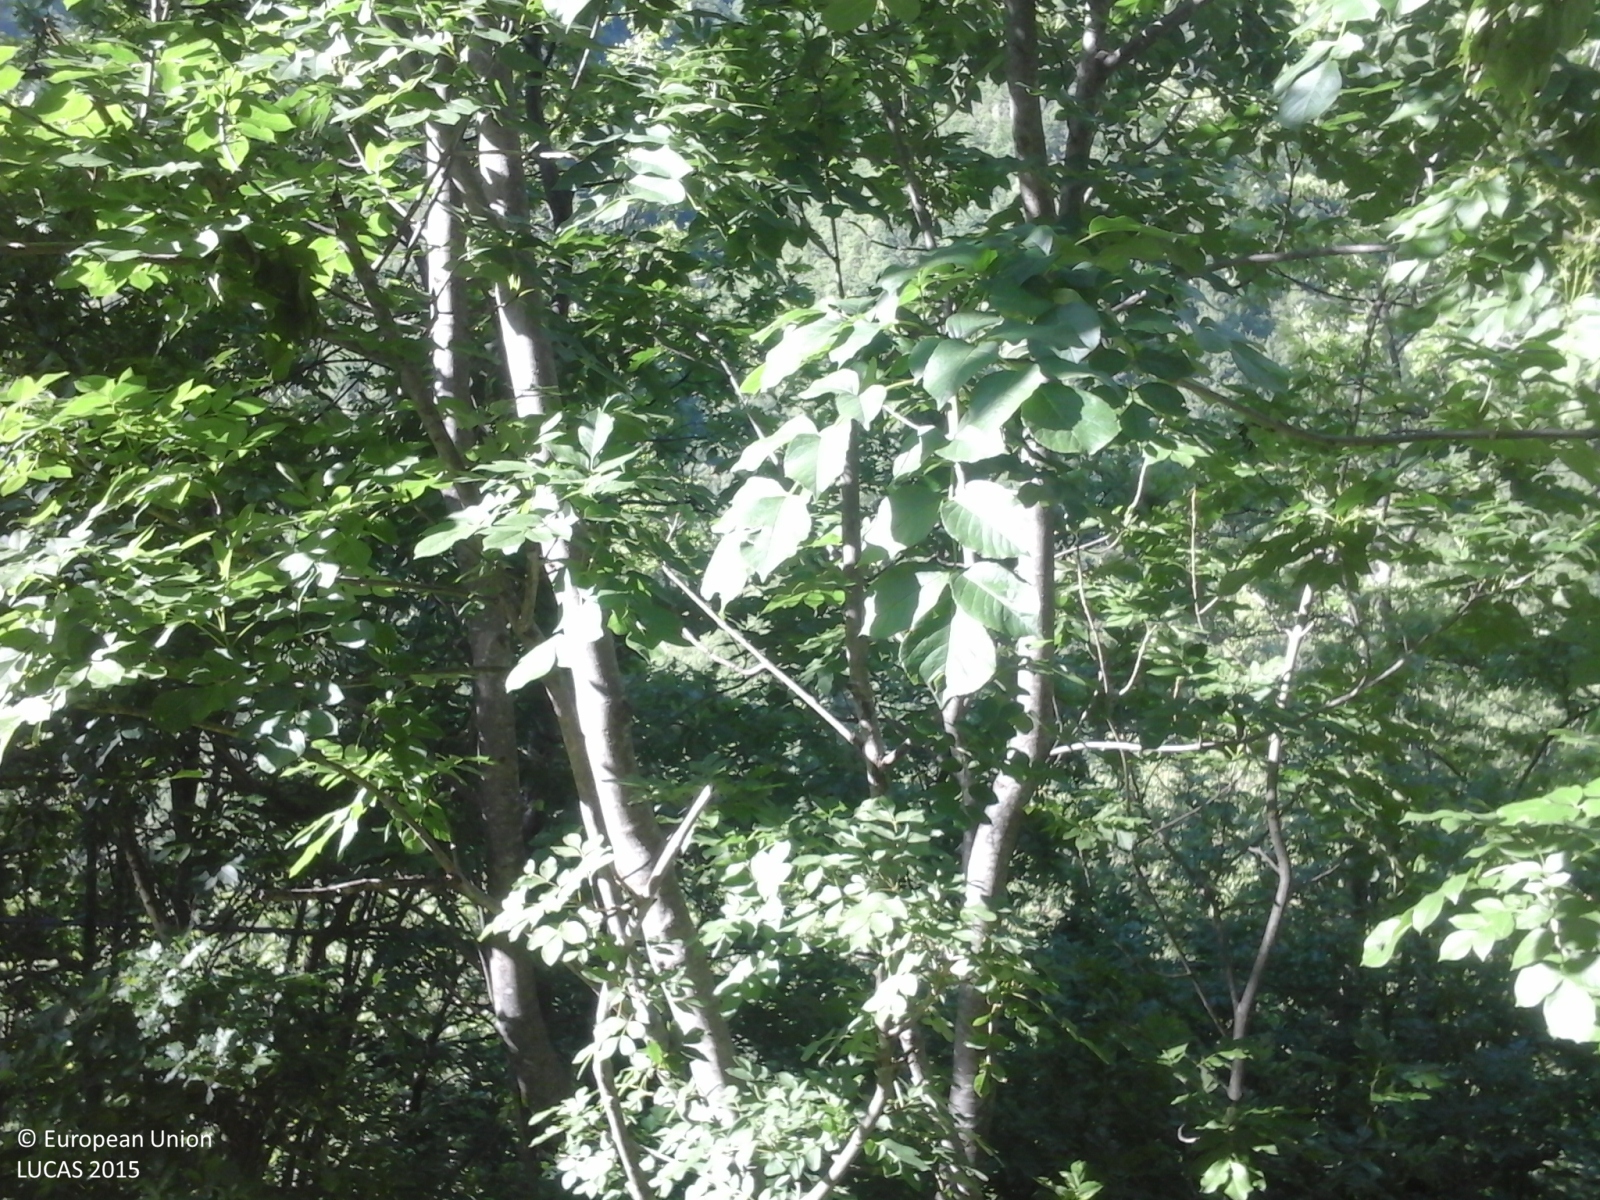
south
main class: Woodland
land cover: Broadleaved woodland
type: thermophilous deciduous forest
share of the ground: > 75 %
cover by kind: broadleaved forest trees 100 %
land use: Forestry
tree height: > 5 m
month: May
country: IT
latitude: 44.0938
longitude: 10.9345
